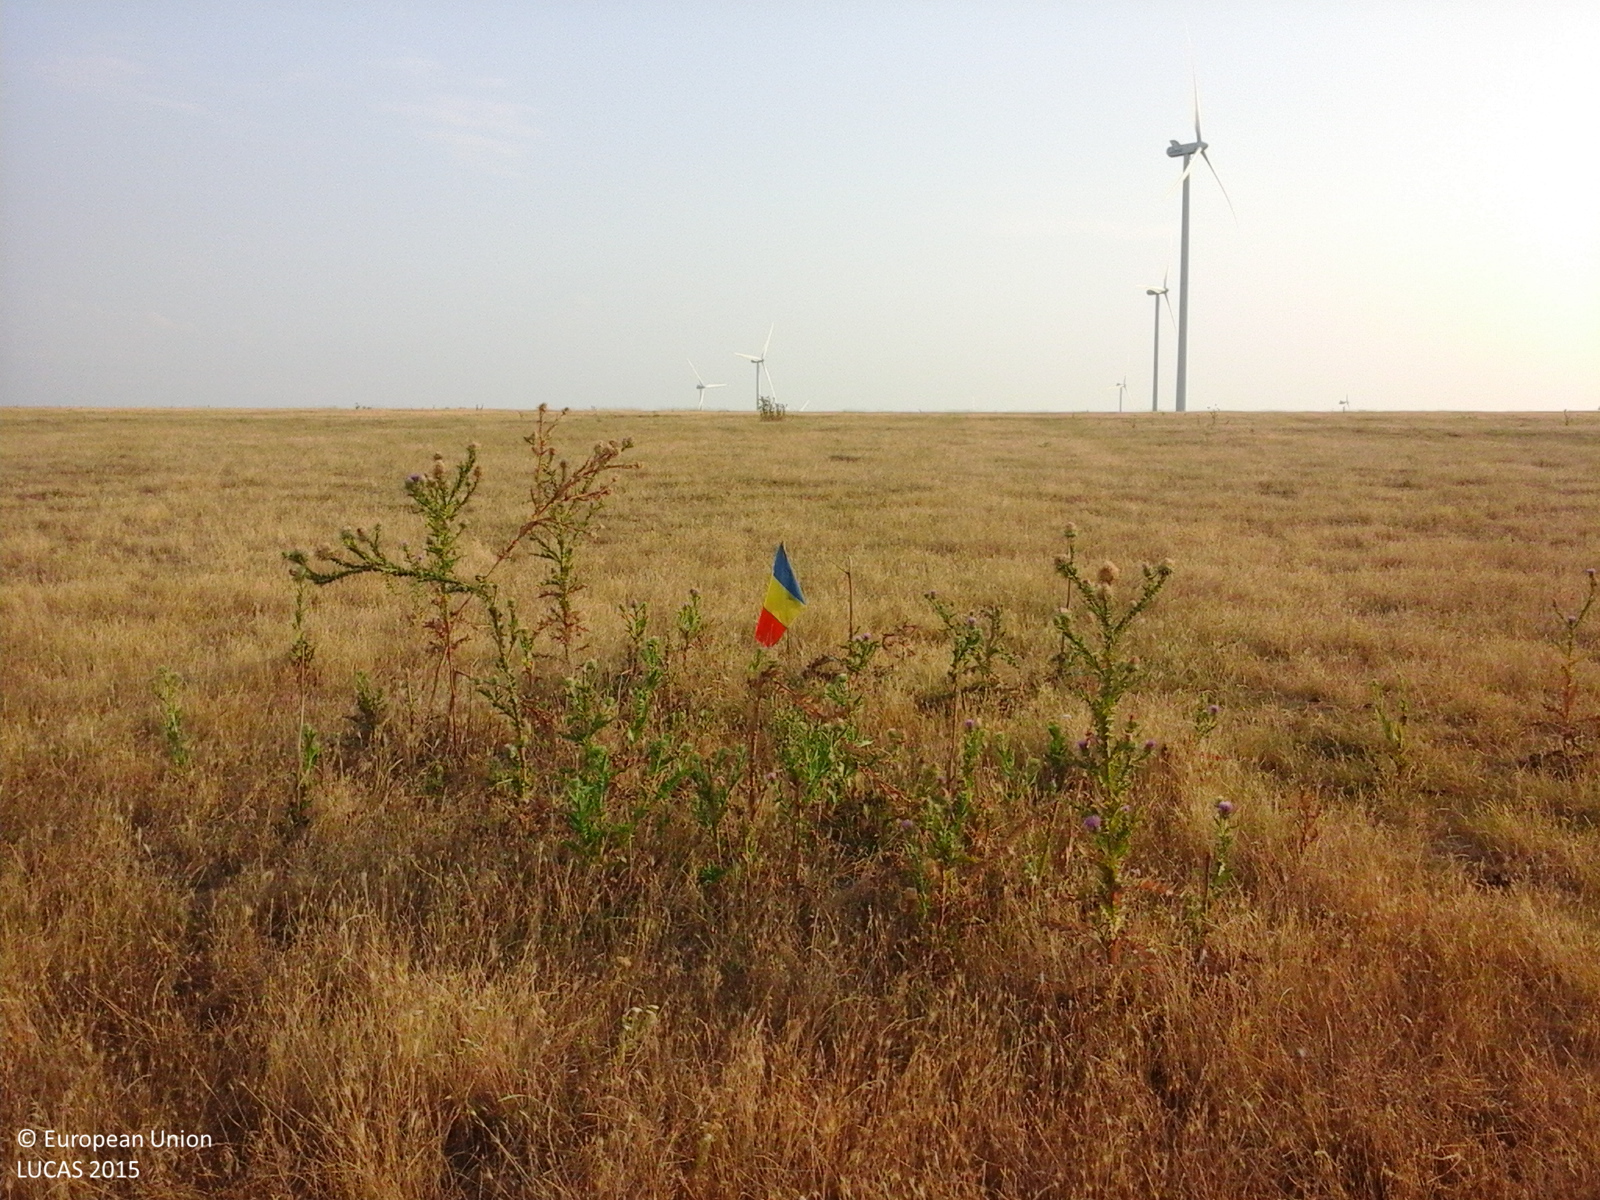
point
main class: Grassland
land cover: Grassland without tree/shrub cover
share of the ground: > 75 %
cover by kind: herbaceous plants 100 %
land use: Agriculture (excluding fallow land and kitchen gardens)
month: July
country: RO
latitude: 44.9075
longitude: 28.3748
